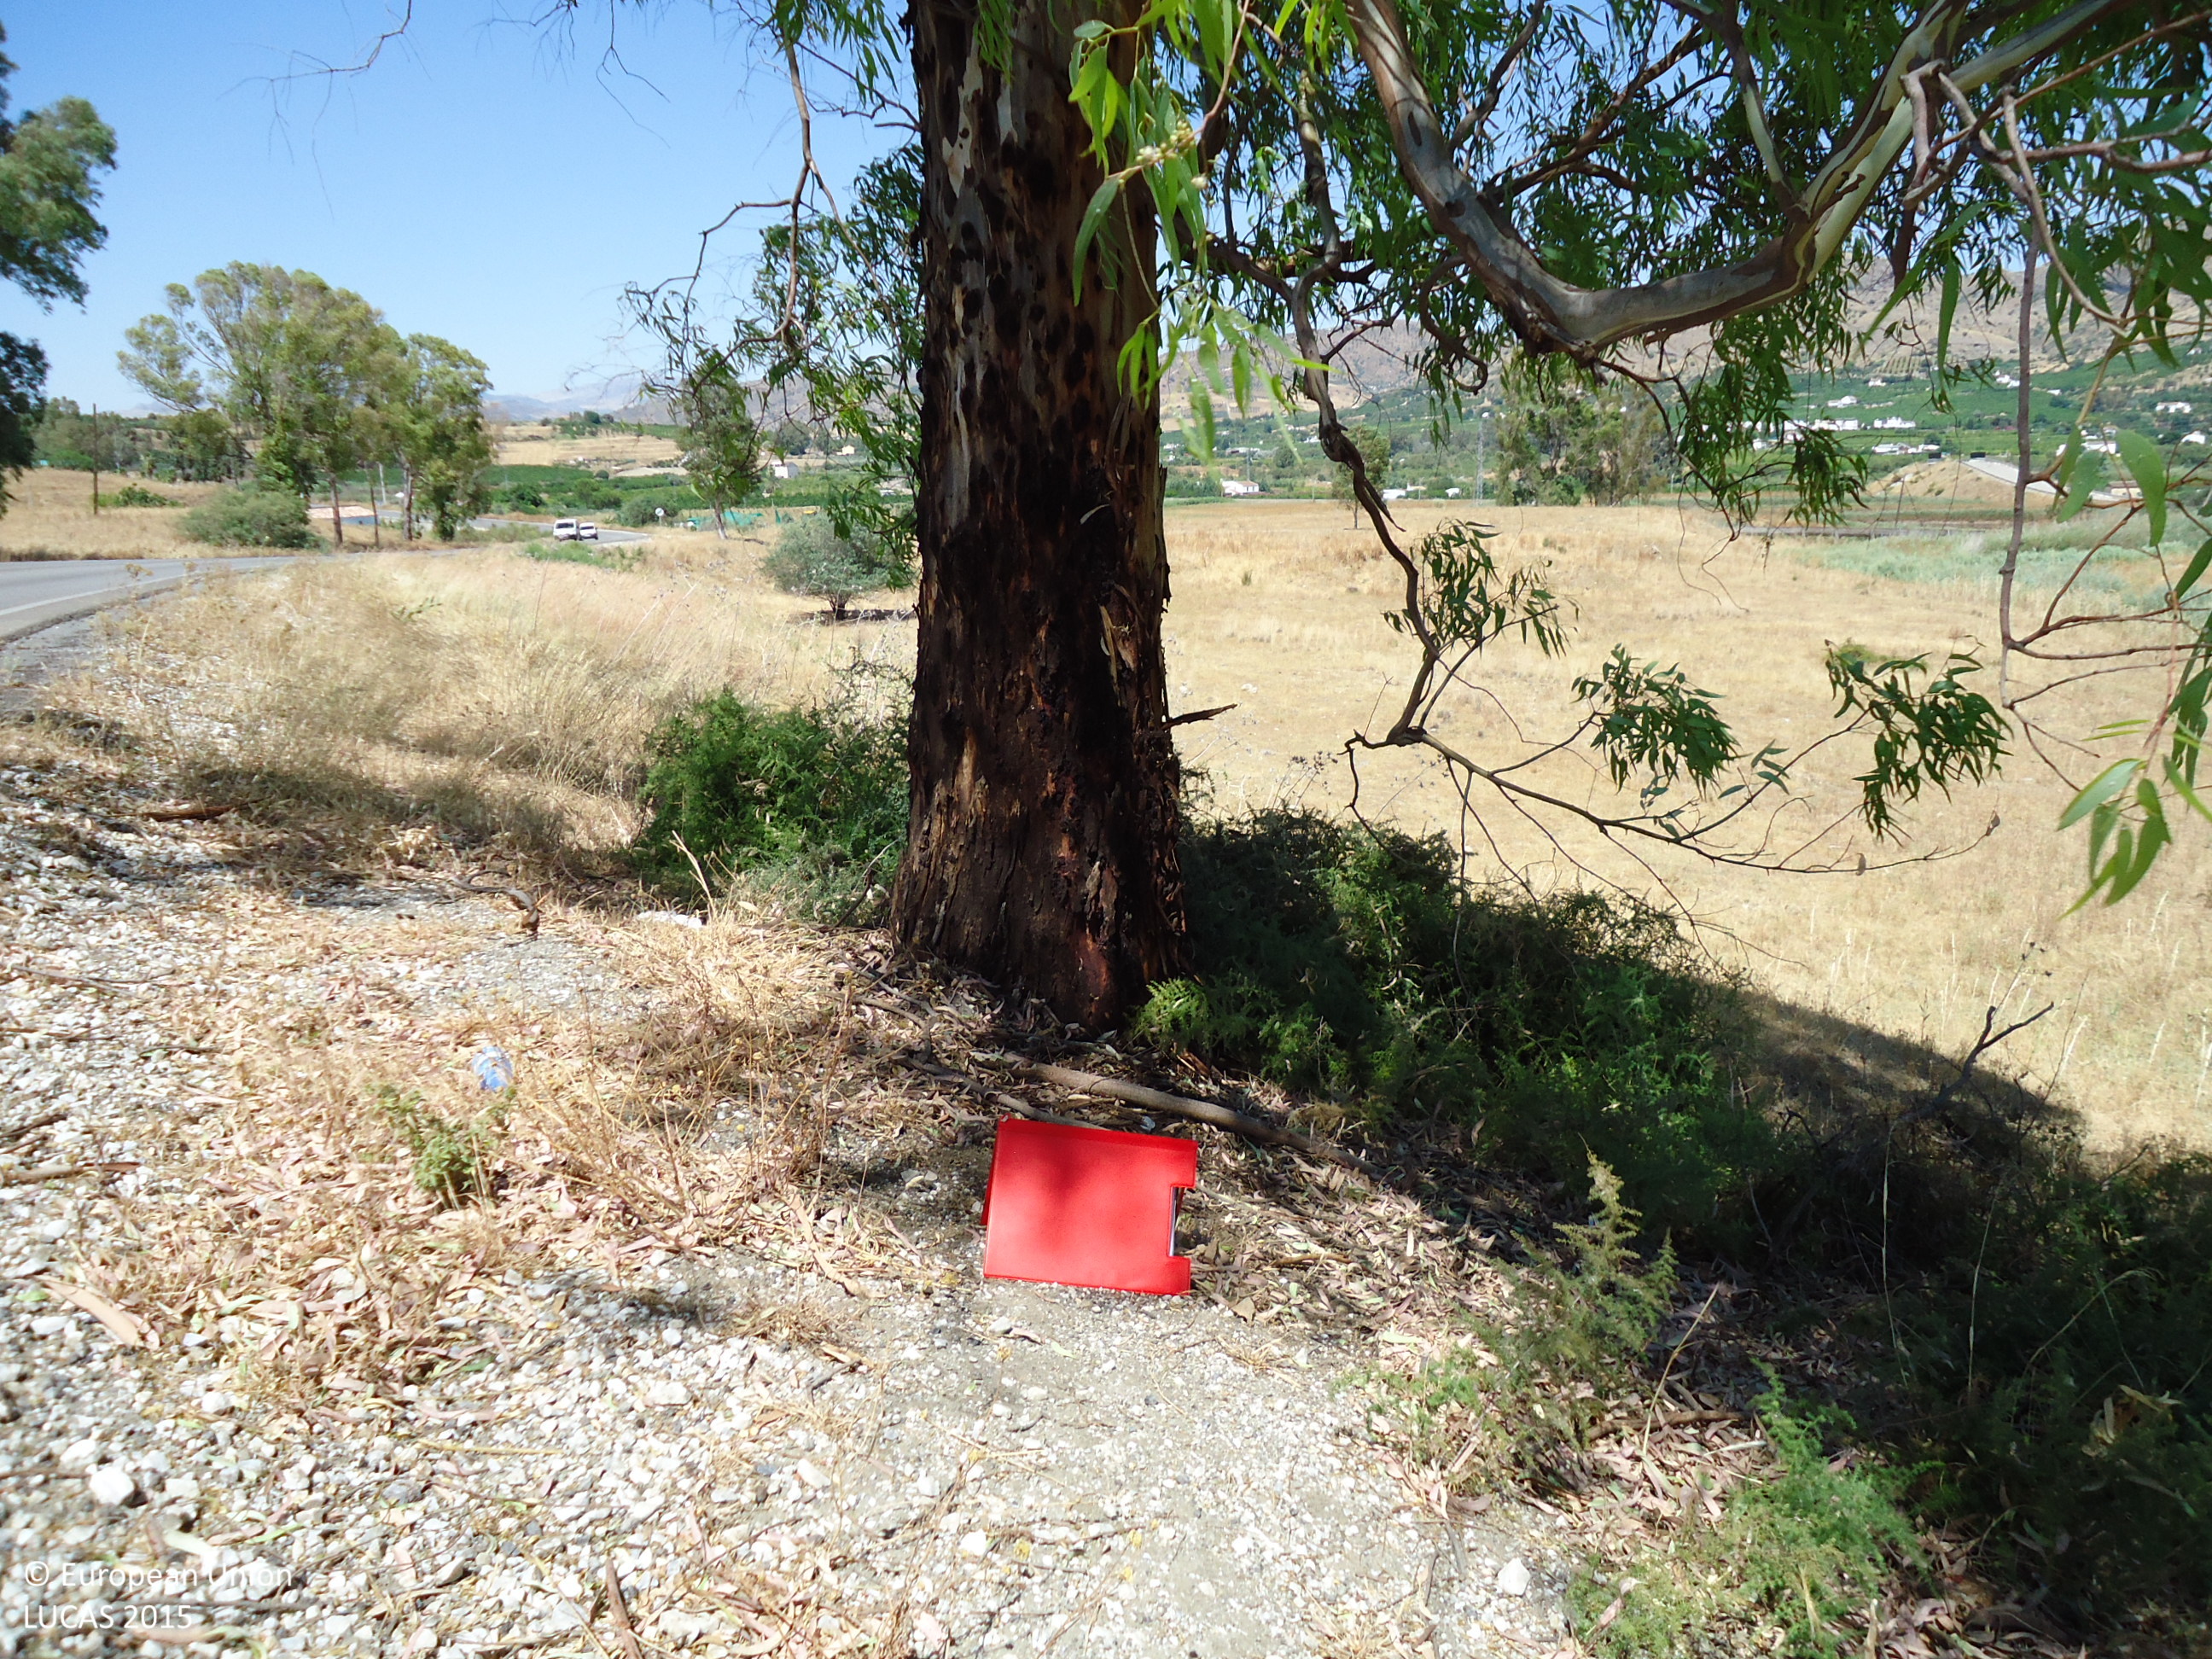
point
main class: Woodland
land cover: Broadleaved woodland
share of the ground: 25 - 50 %
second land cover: Grassland without tree/shrub cover
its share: > 75 %
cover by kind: herbaceous plants 70 %, broadleaved forest trees 30 %
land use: Forestry
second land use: Agriculture (excluding fallow land and kitchen gardens)
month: June
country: ES
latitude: 36.7779
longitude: -4.7283
